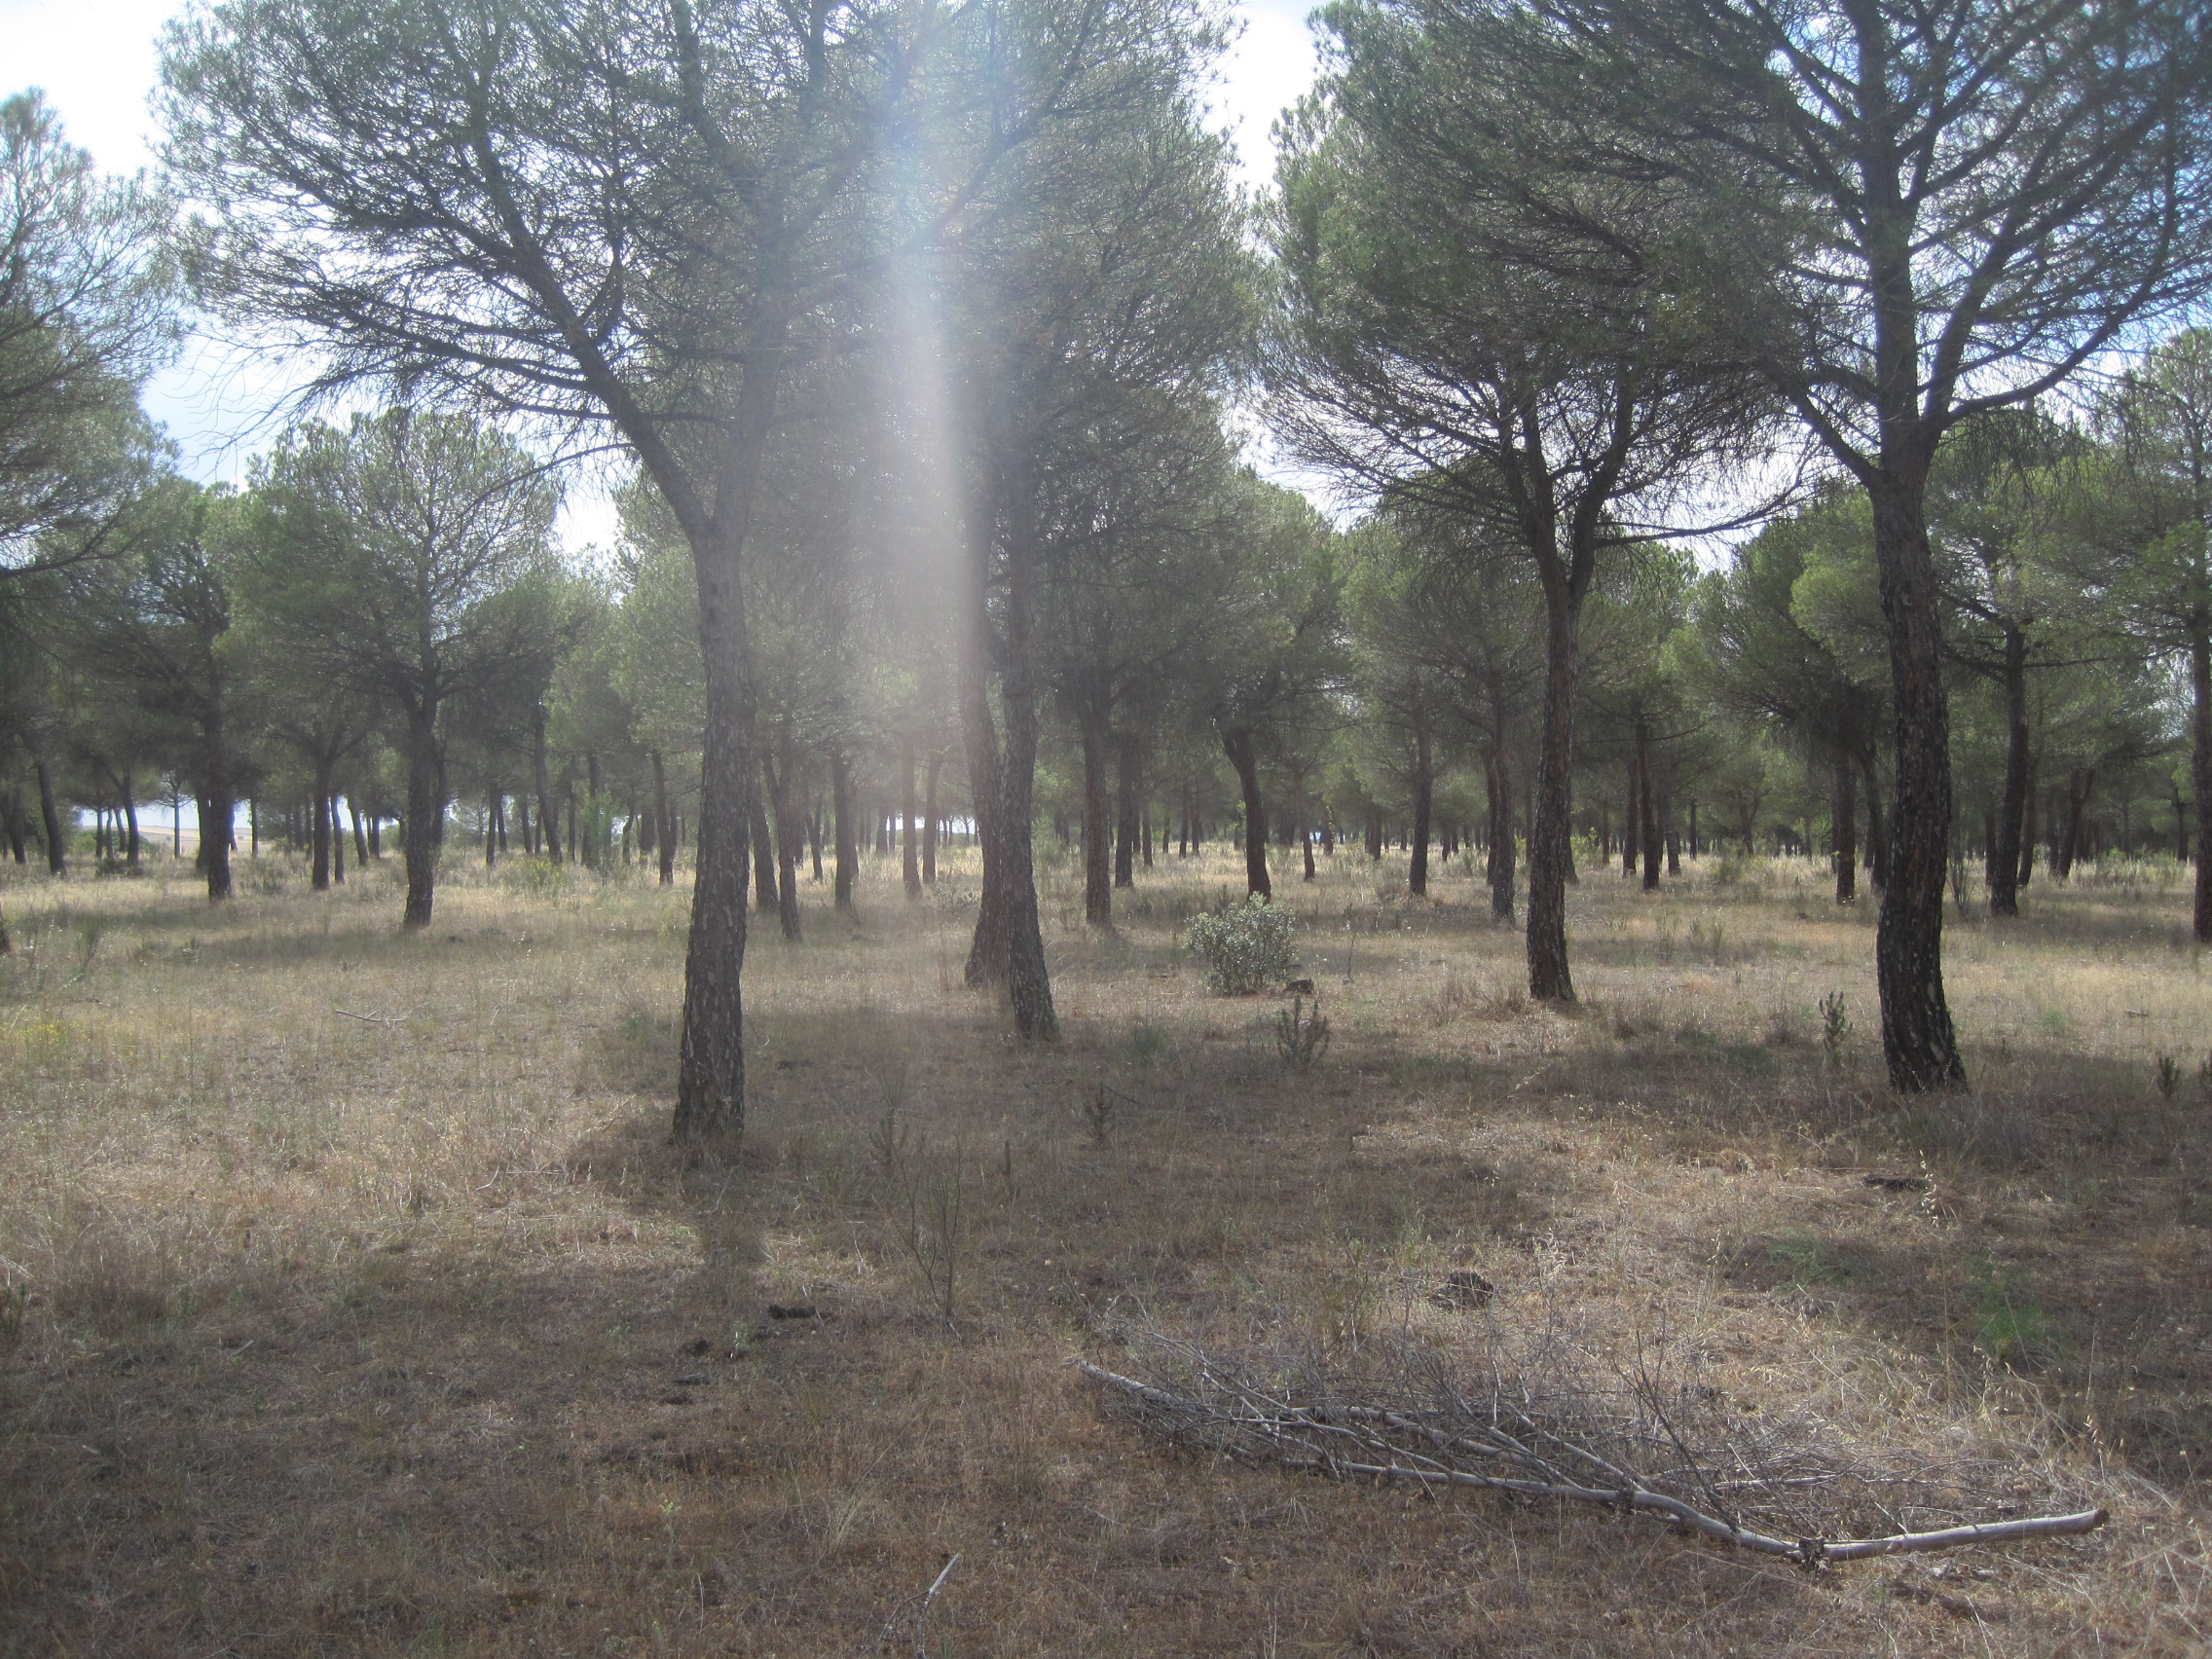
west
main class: Woodland
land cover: Pine dominated coniferous woodland
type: coniferous forest of the mediterranean region
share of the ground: 50 - 75 %
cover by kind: coniferous forest trees 70 %, herbaceous plants 30 %
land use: Forestry
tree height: > 5 m
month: June
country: ES
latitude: 41.4279
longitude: -5.0660
